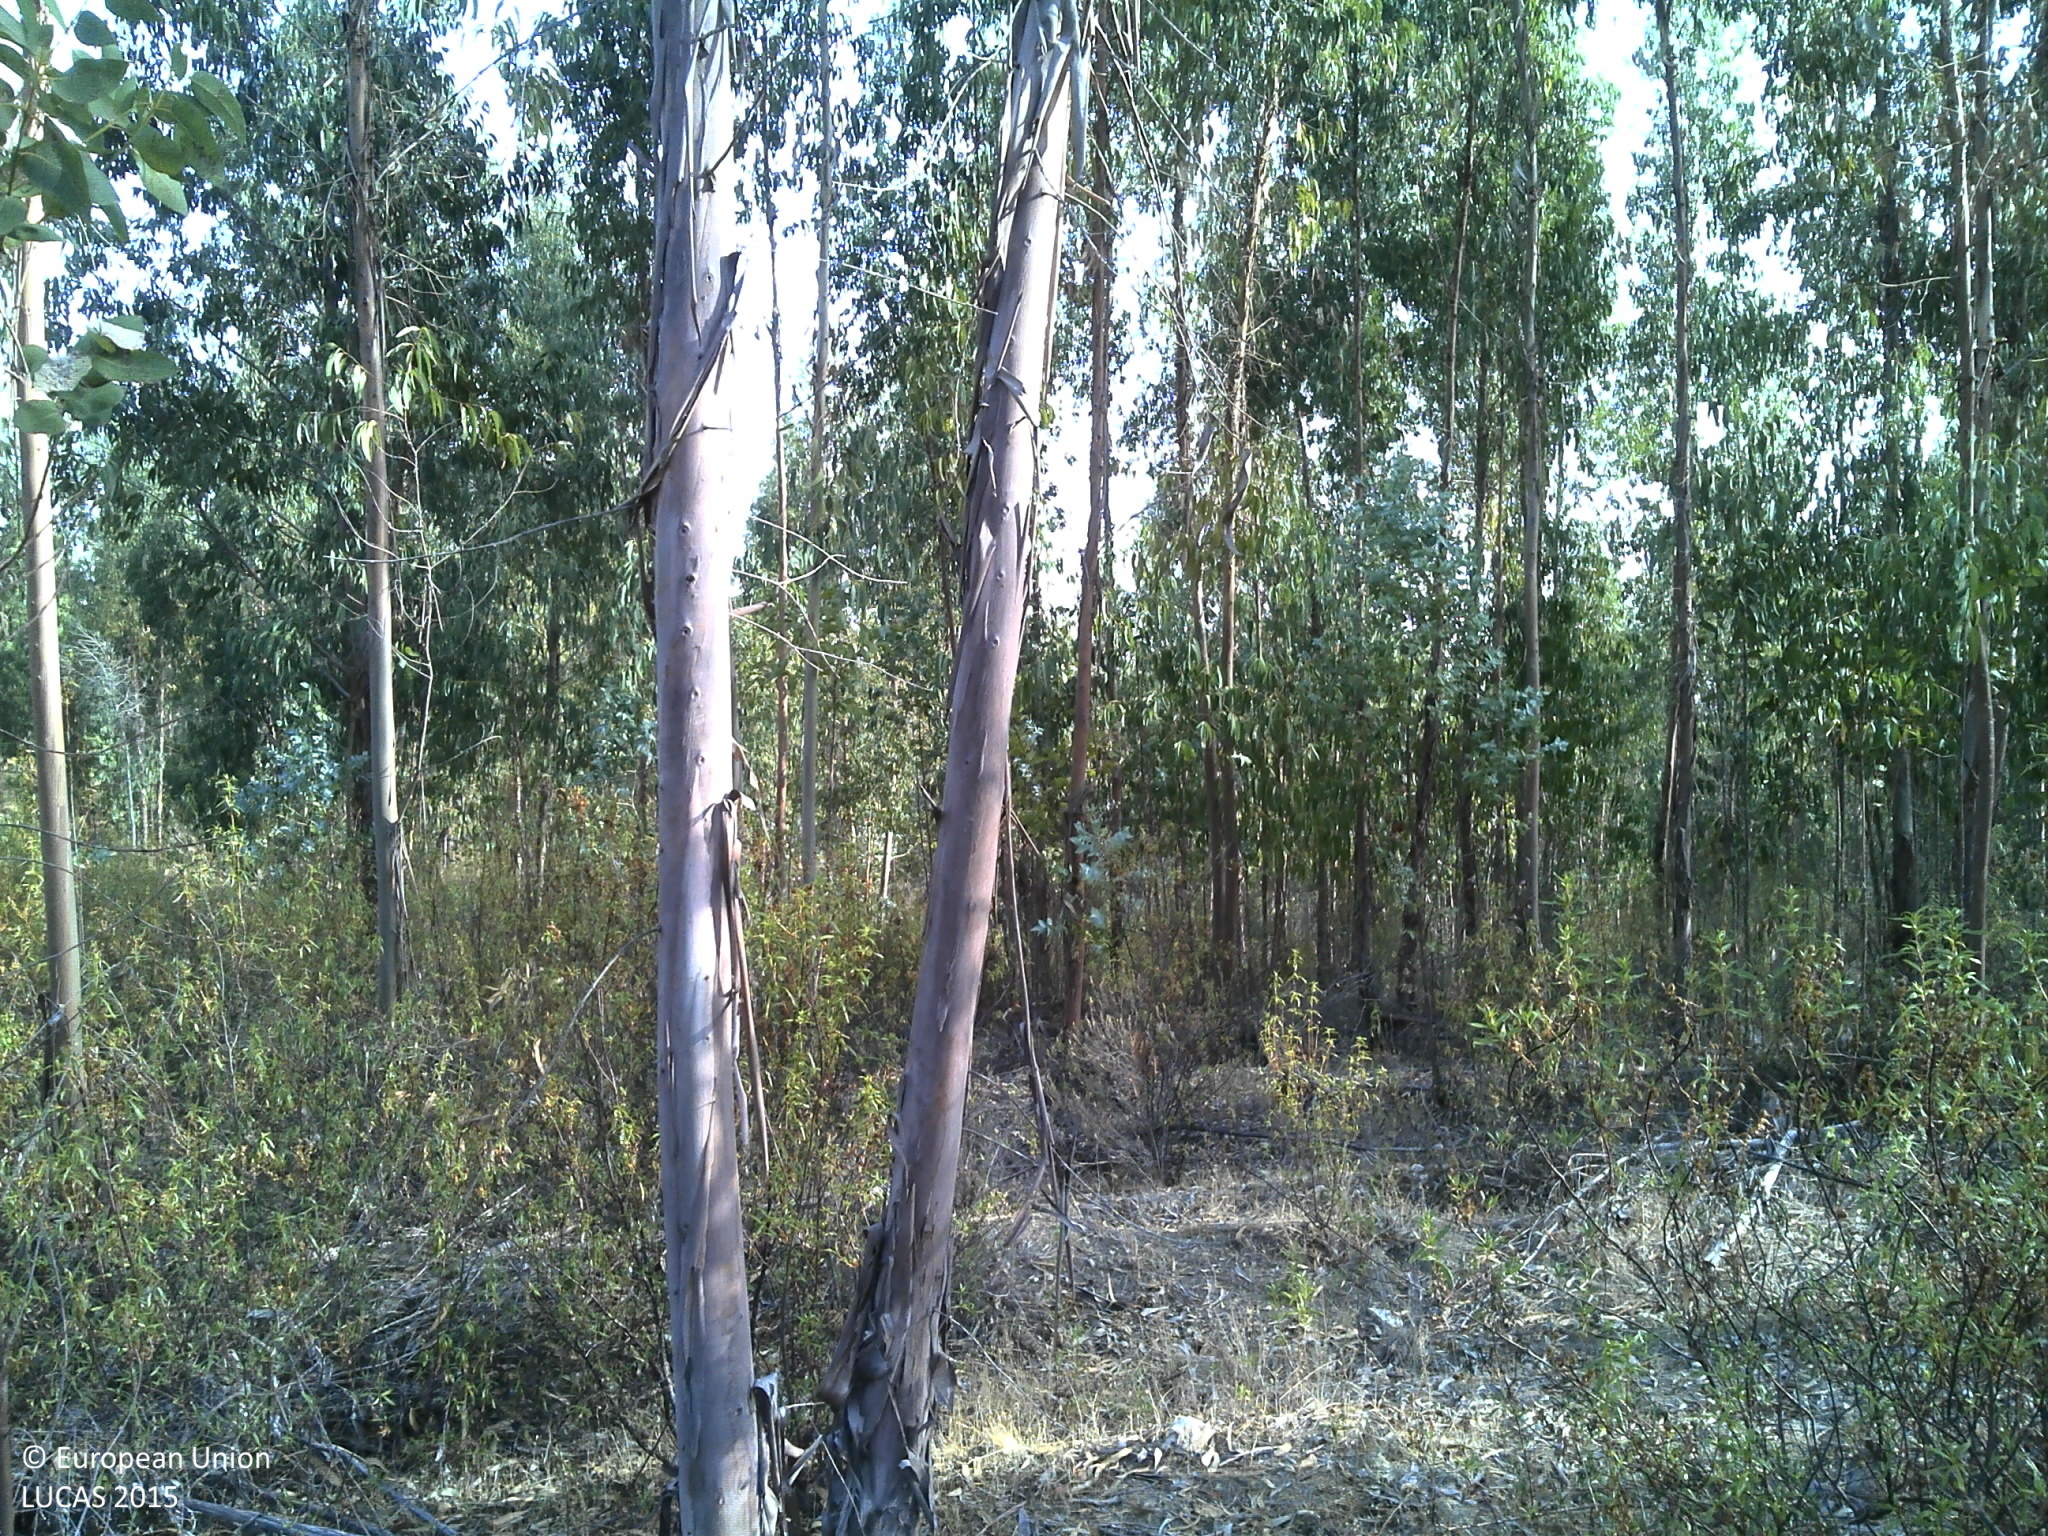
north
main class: Woodland
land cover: Broadleaved woodland
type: exotic forest
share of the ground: 25 - 50 %
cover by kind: shrubs 50 %, broadleaved forest trees 40 %, unconsolidated bare surface 10 %
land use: Forestry
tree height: > 5 m
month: July
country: PT
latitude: 38.6549
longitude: -7.4390
